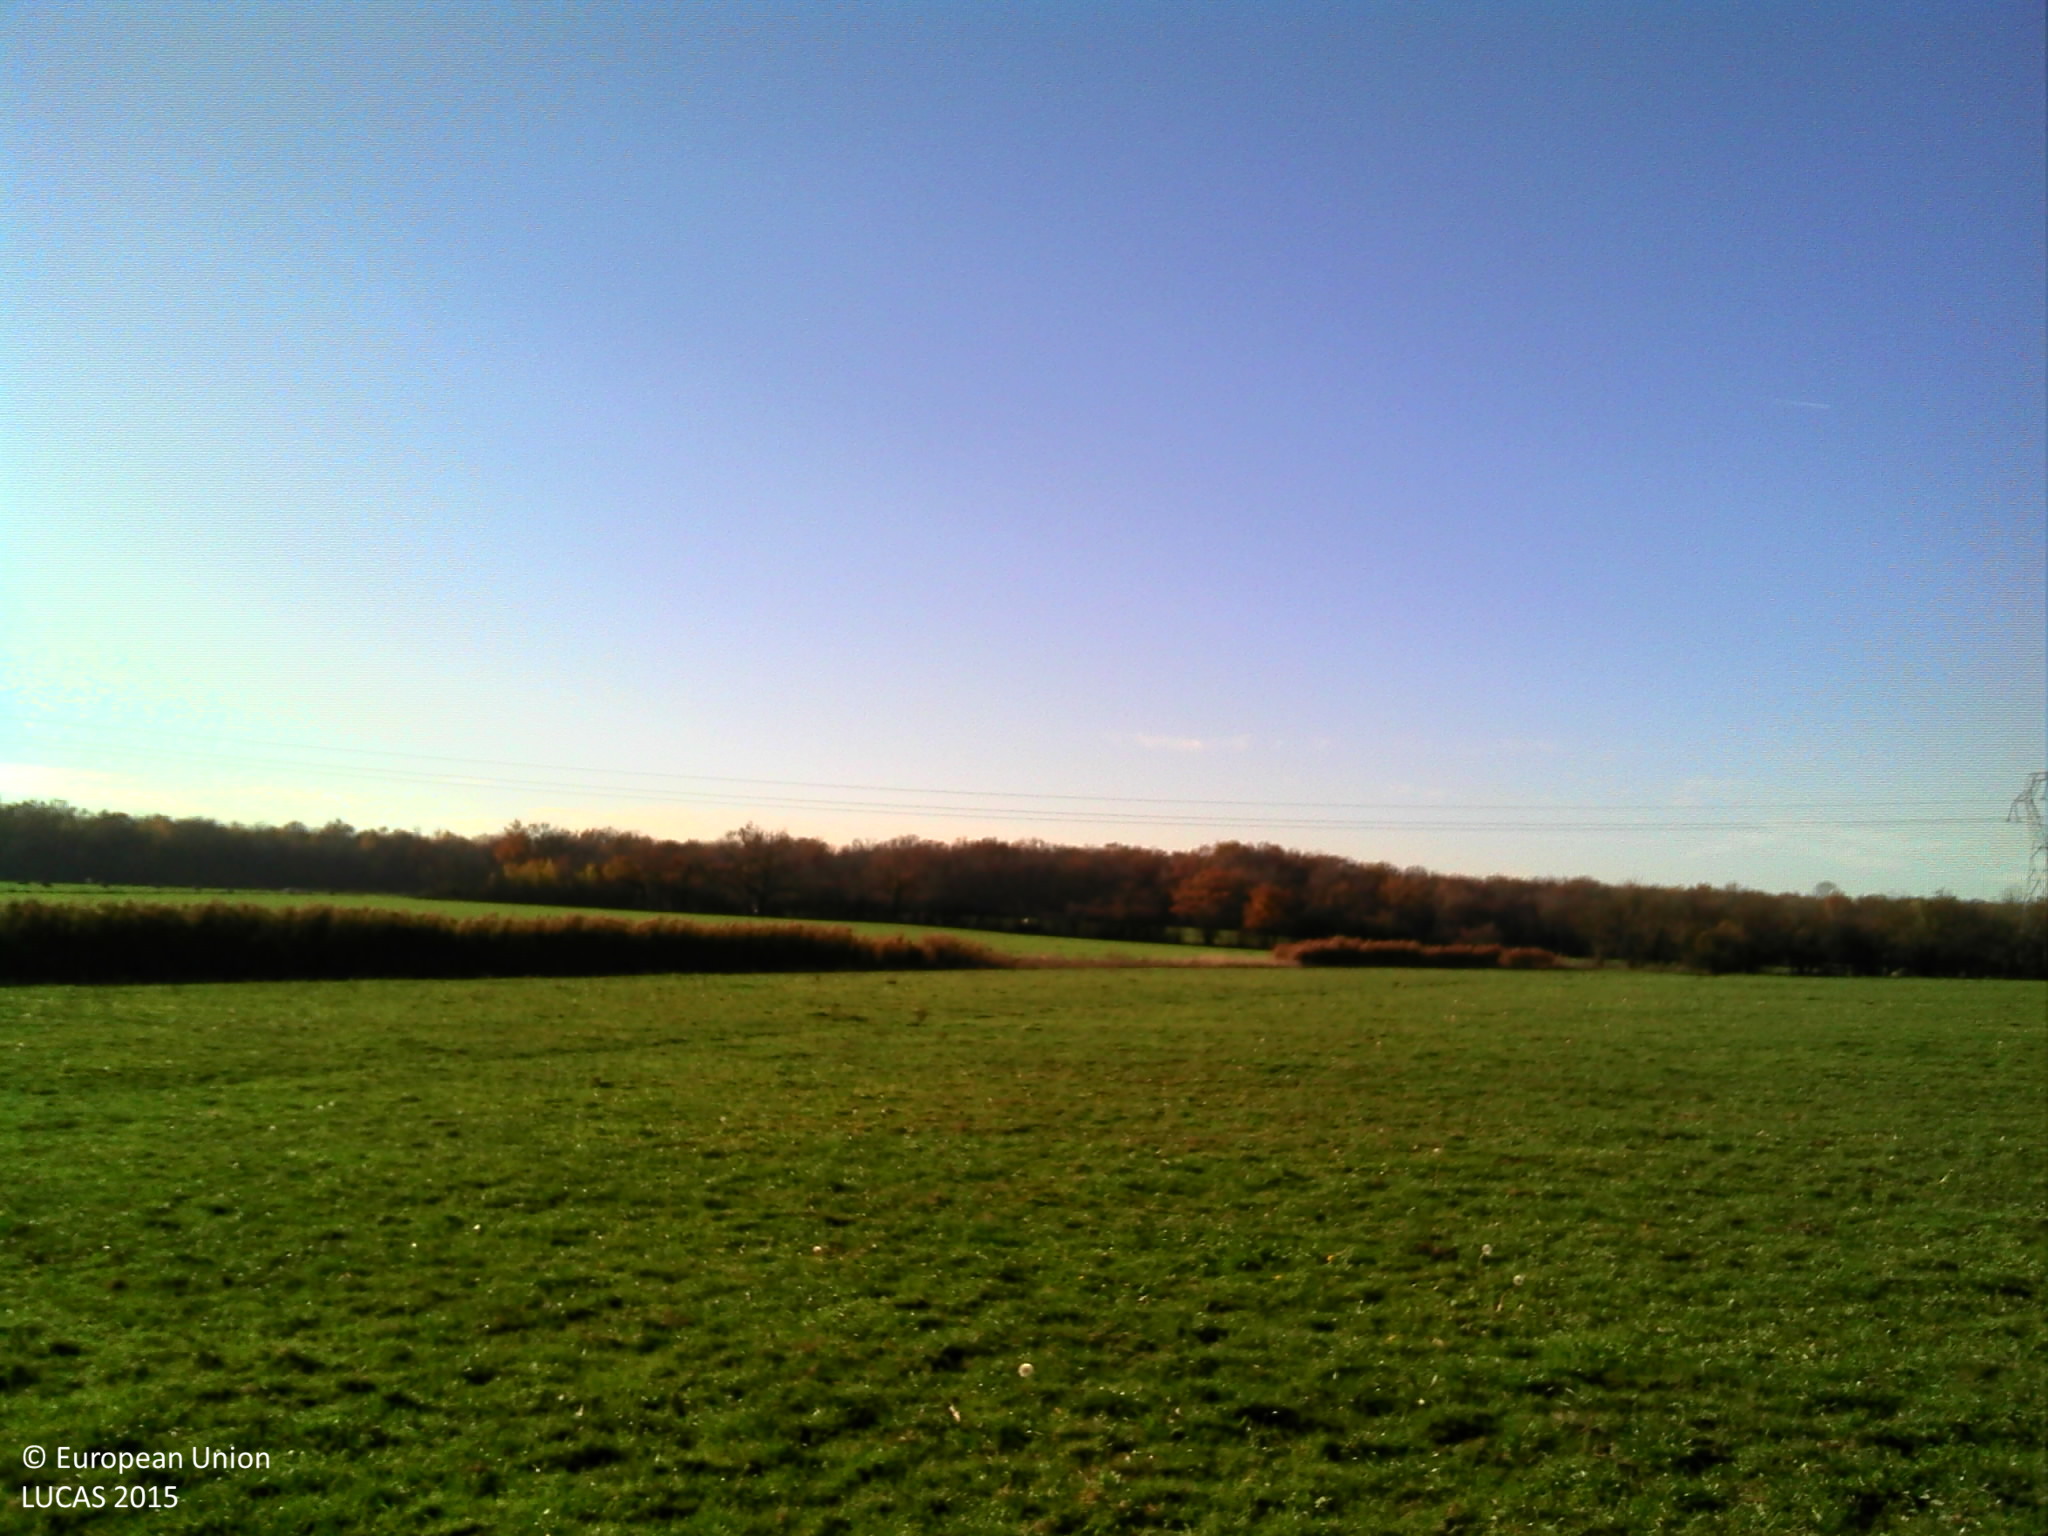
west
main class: Grassland
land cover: Grassland without tree/shrub cover
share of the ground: > 75 %
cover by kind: herbaceous plants 100 %
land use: Agriculture (excluding fallow land and kitchen gardens)
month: December
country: FR
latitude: 46.0323
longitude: 4.9255
